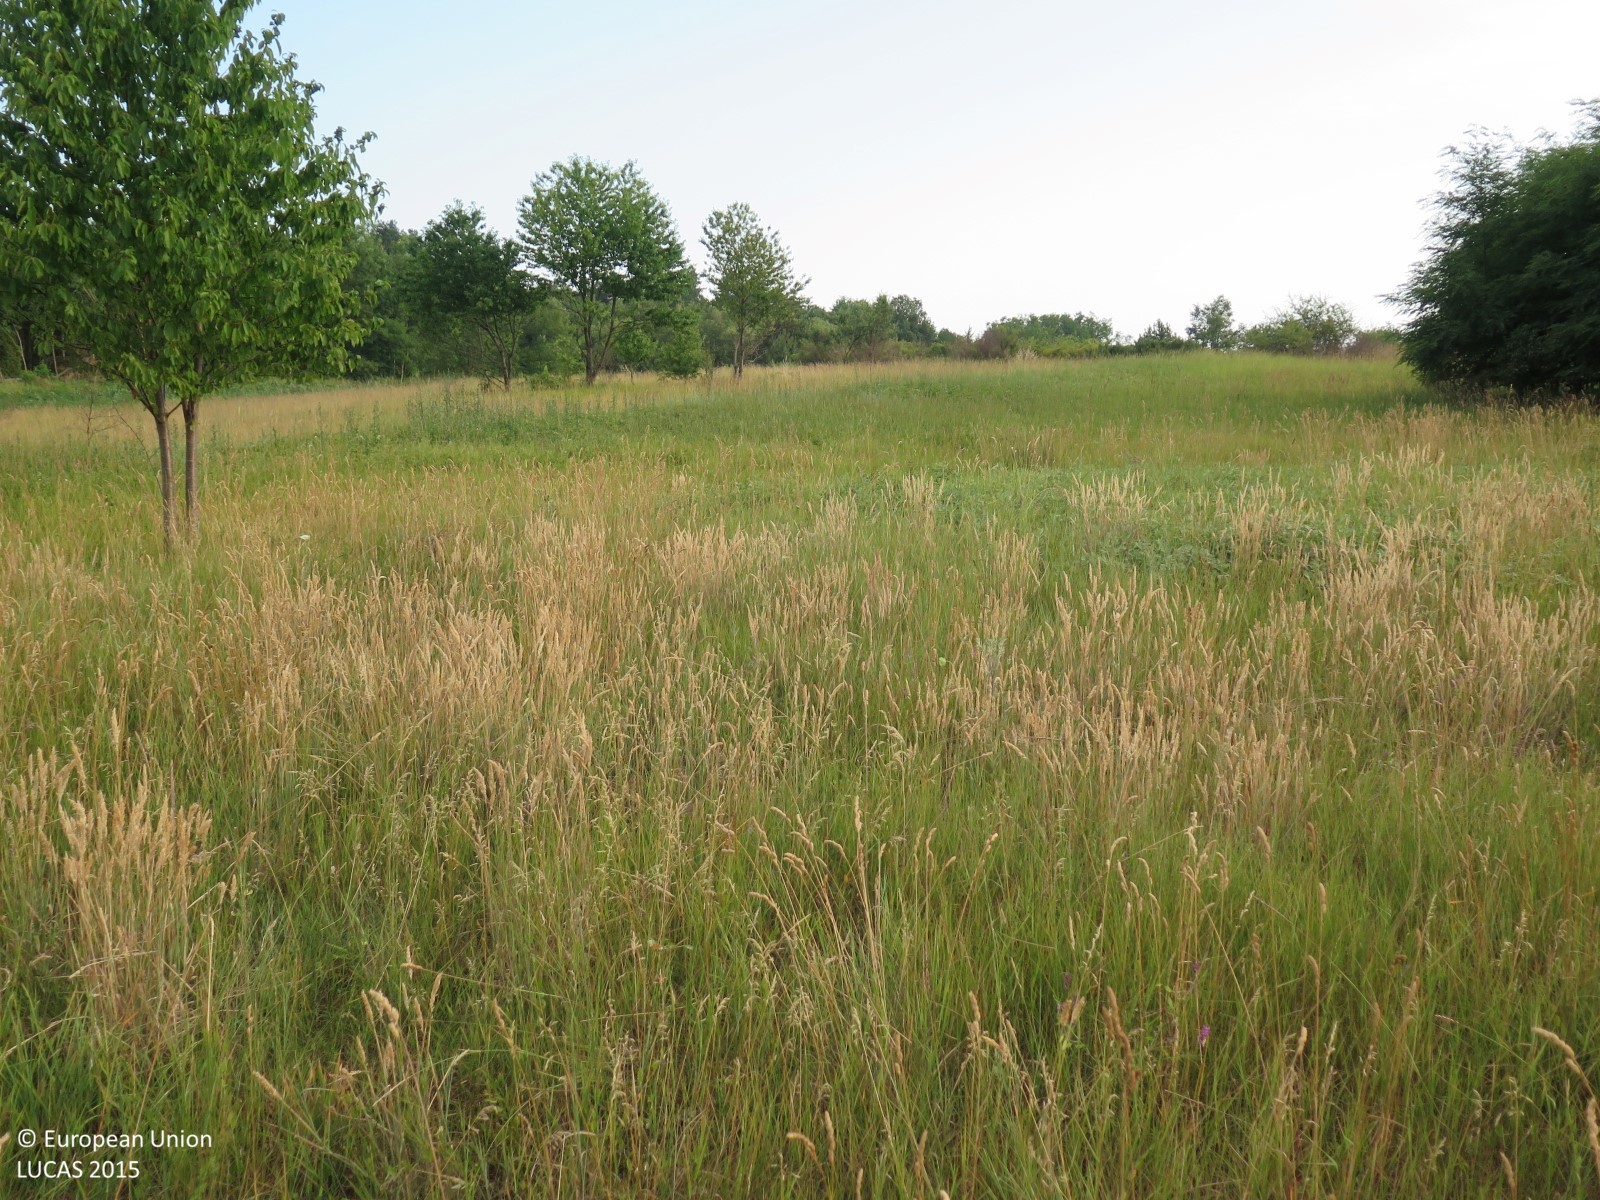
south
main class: Grassland
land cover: Grassland without tree/shrub cover
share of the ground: > 75 %
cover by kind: herbaceous plants 100 %
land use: Agriculture (excluding fallow land and kitchen gardens)
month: July
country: HR
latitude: 45.2545
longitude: 13.8303
